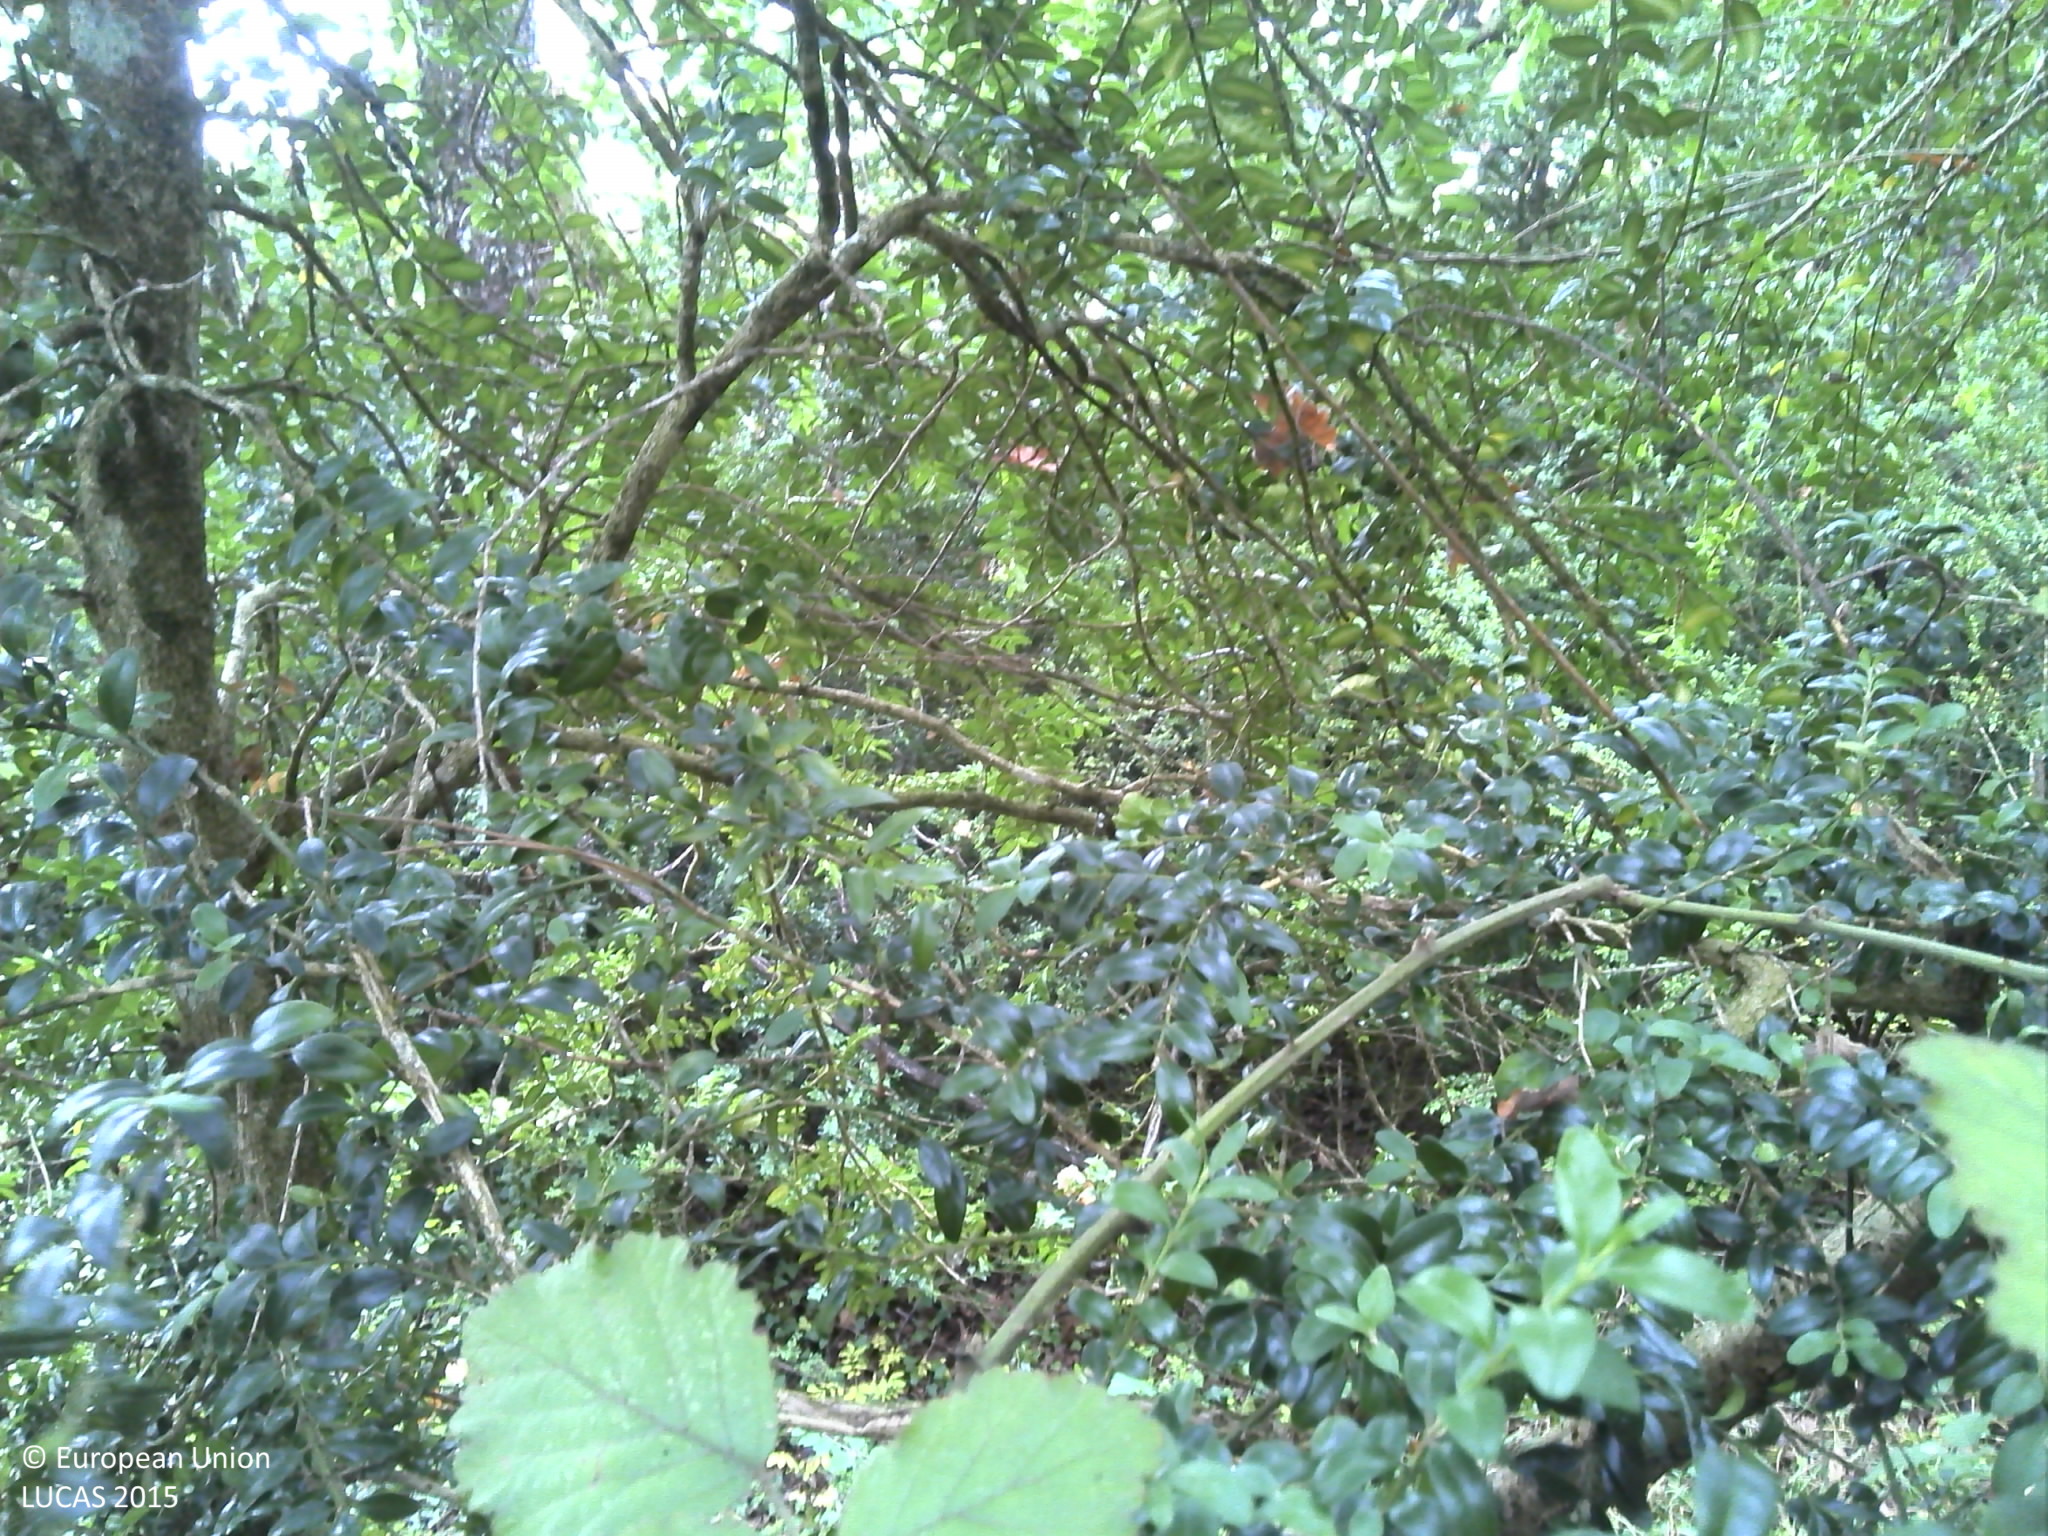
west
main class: Woodland
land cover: Broadleaved woodland
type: acidophilous oak and oak-birch forest
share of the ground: 50 - 75 %
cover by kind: broadleaved forest trees 50 %, herbaceous plants 30 %, shrubs 20 %
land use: Forestry
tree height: > 5 m
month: October
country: FR
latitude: 46.3241
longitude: 5.3920
